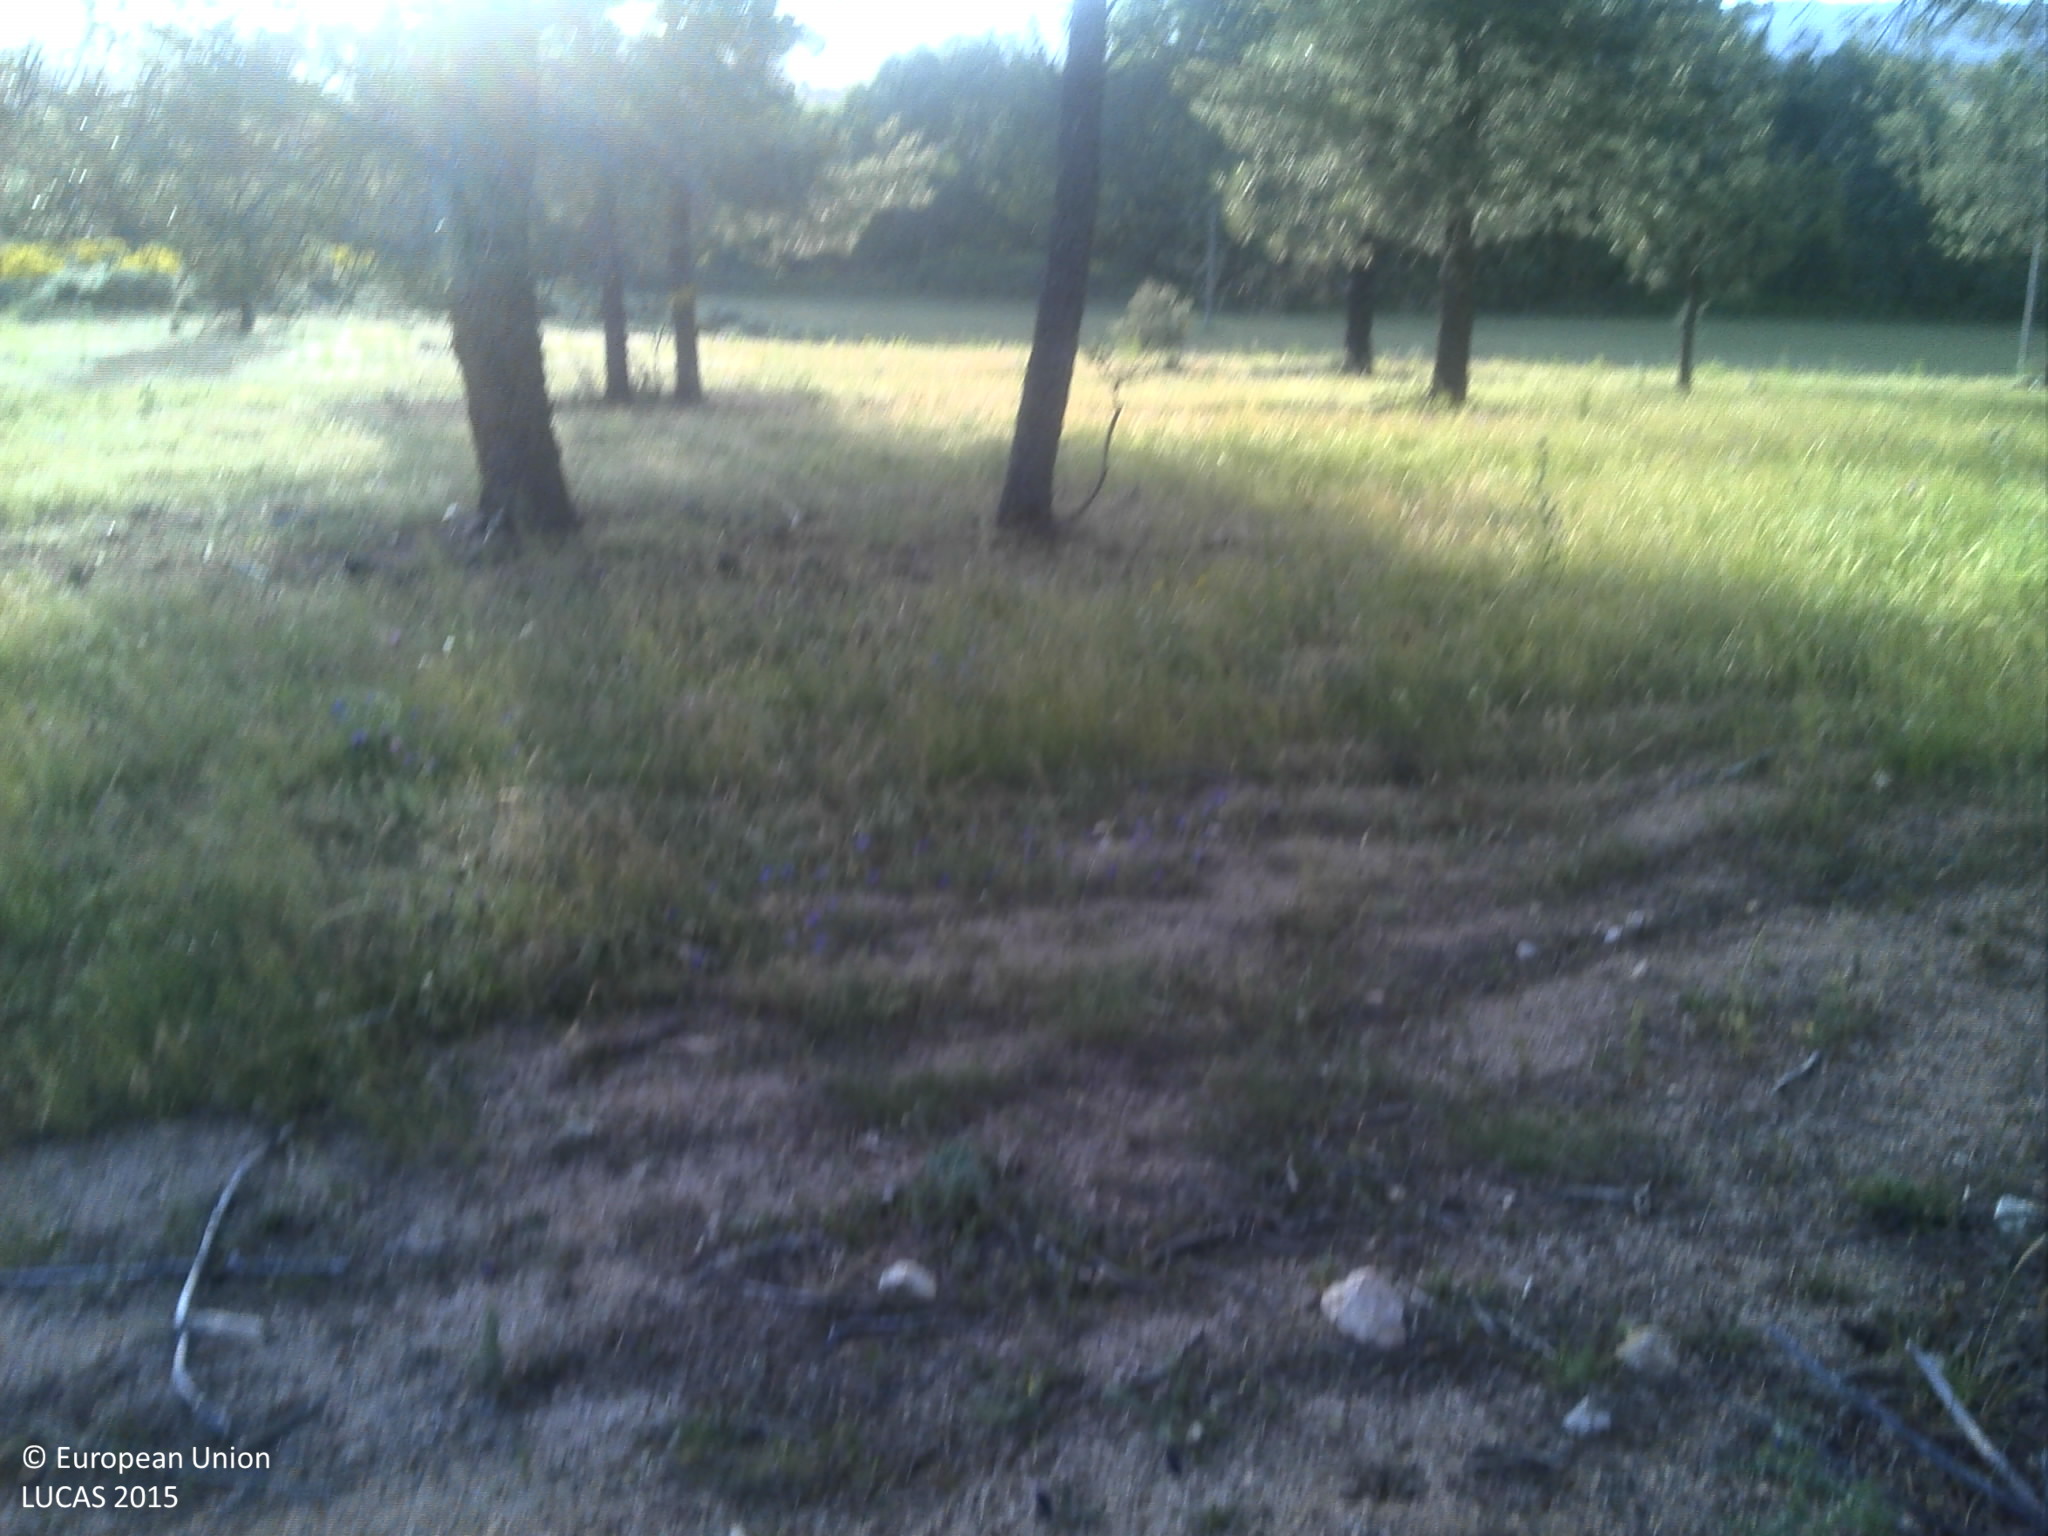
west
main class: Woodland
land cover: Pine dominated coniferous woodland
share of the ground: 10 - 25 %
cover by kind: herbaceous plants 60 %, unconsolidated bare surface 25 %, coniferous forest trees 15 %
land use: Forestry
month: May
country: PT
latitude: 40.7040
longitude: -7.3311
